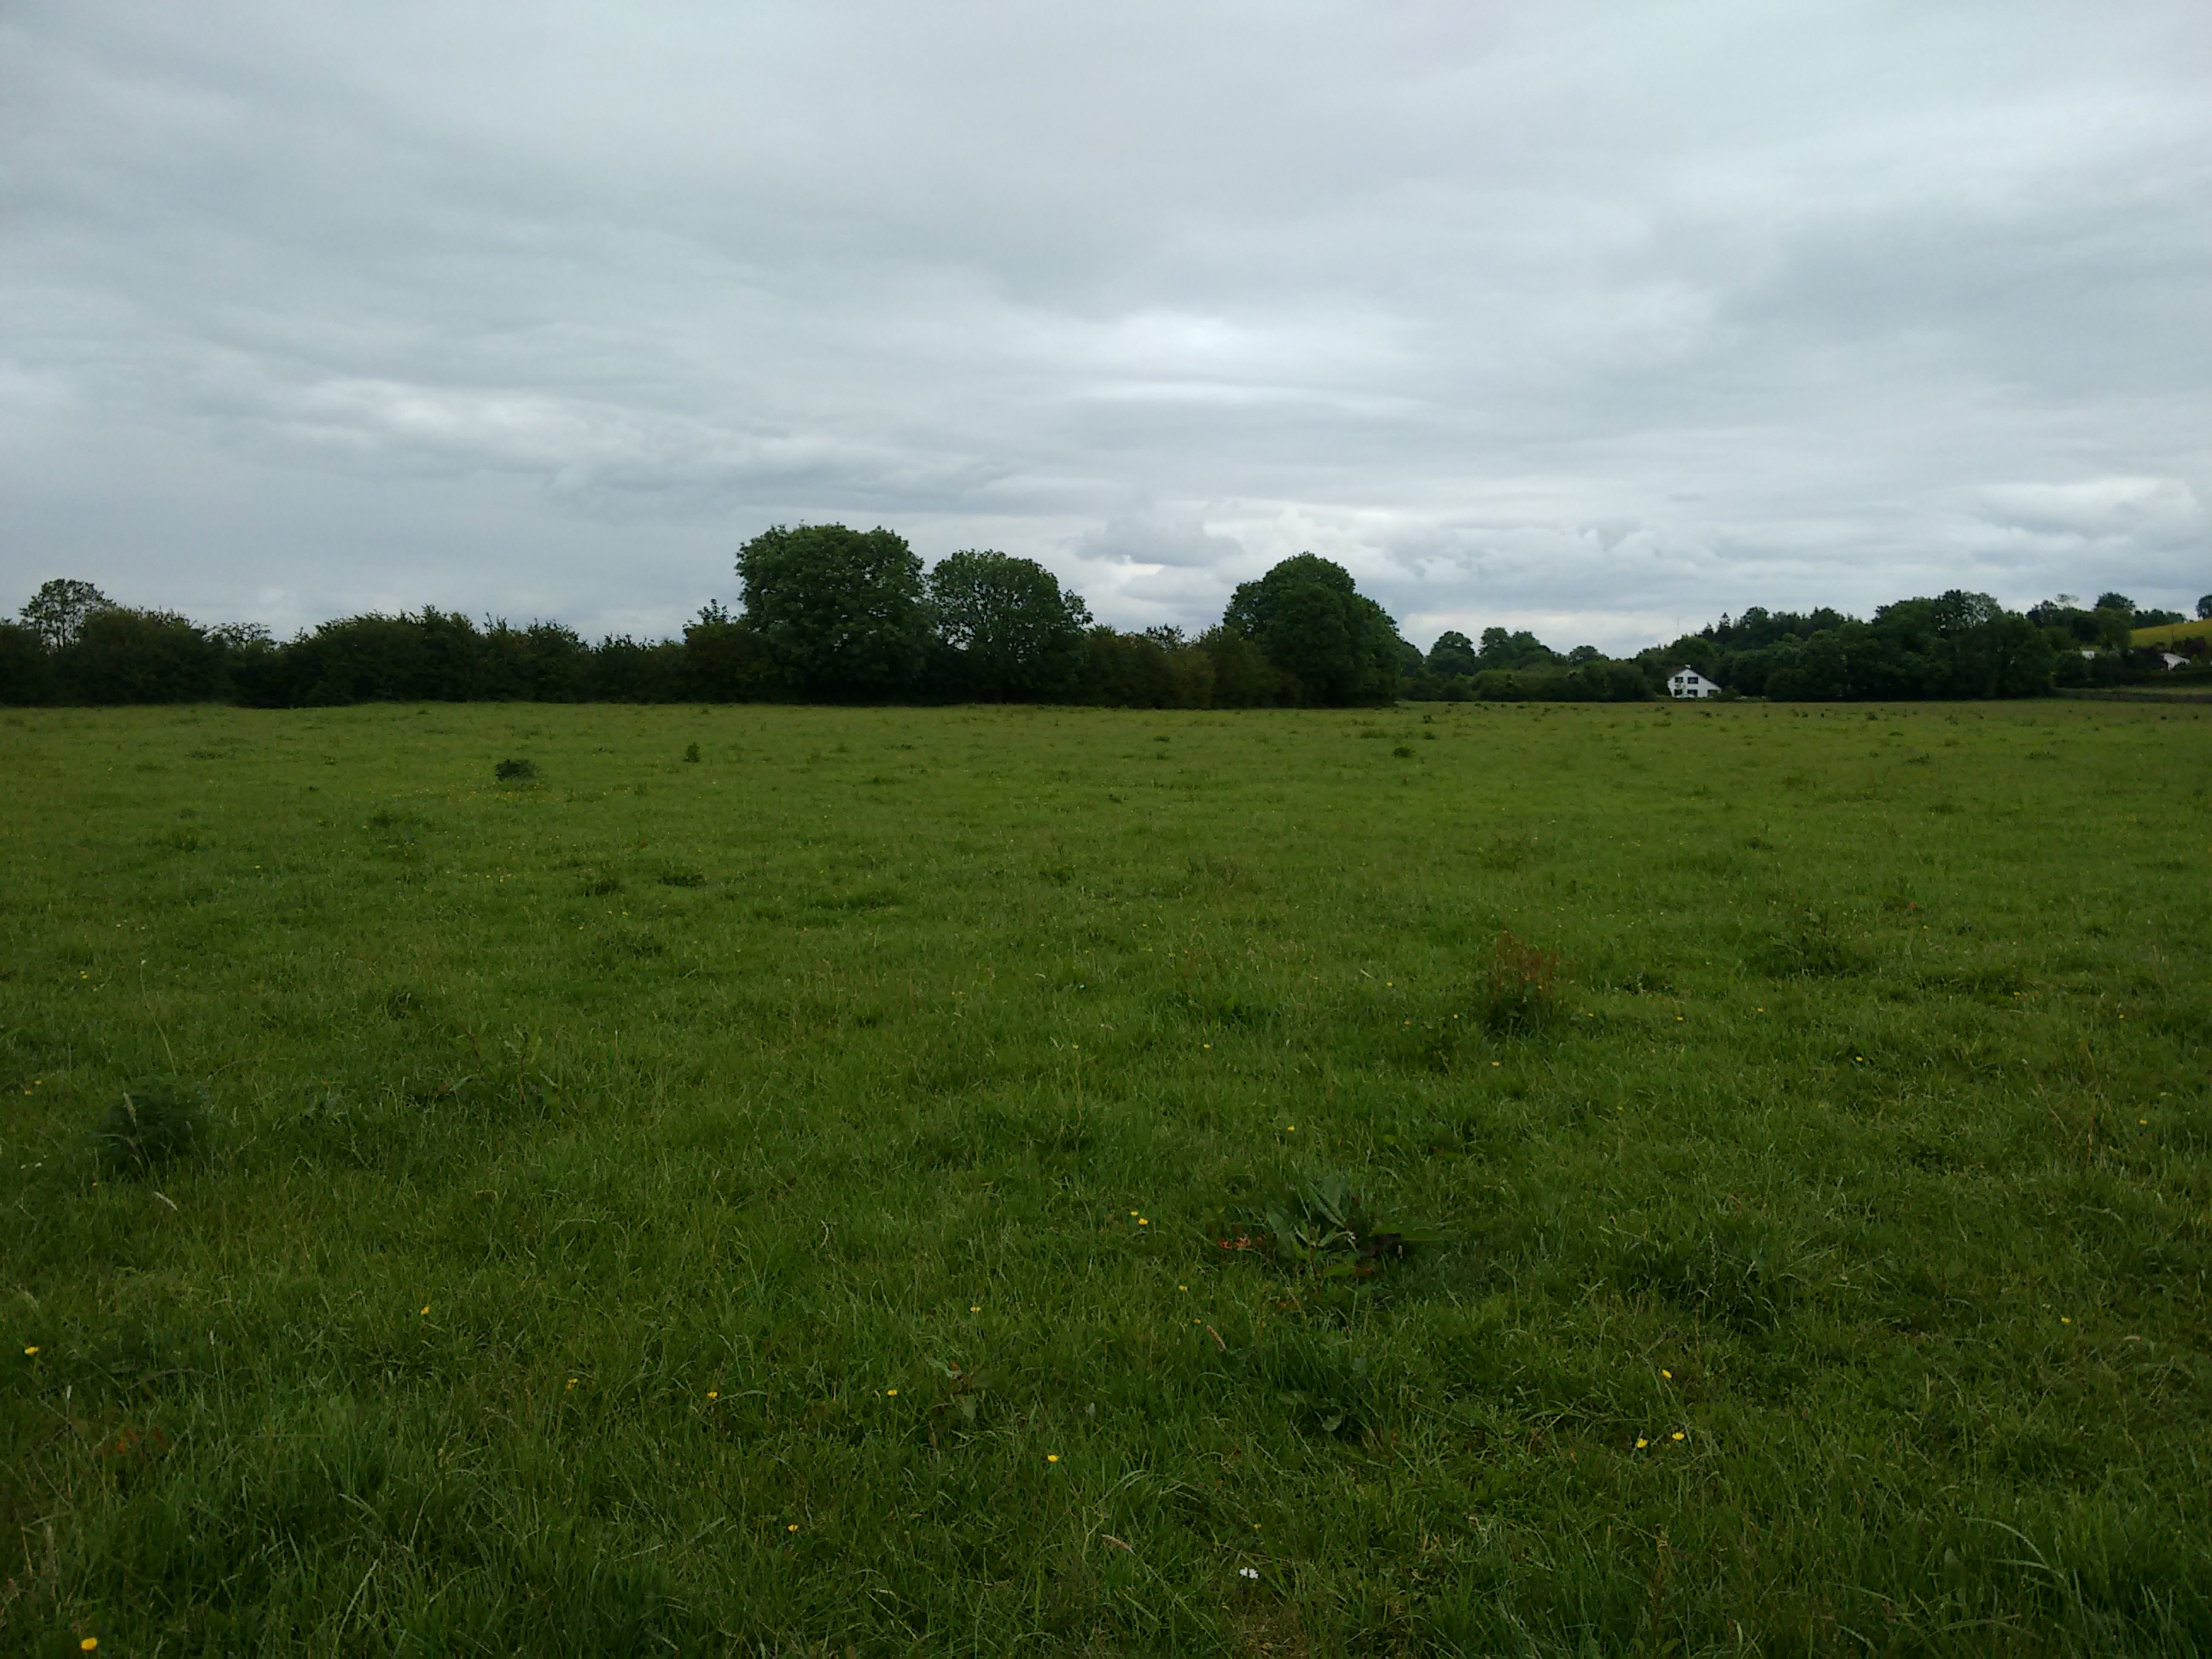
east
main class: Grassland
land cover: Grassland without tree/shrub cover
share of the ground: > 75 %
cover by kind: herbaceous plants 95 %, shrubs 5 %
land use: Agriculture (excluding fallow land and kitchen gardens)
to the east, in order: Grassland without tree/shrub cover; Managed hedges; Ditches and canals; Managed hedges; Grassland without tree/shrub cover
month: June
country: IE
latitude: 53.4025
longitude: -7.8740
